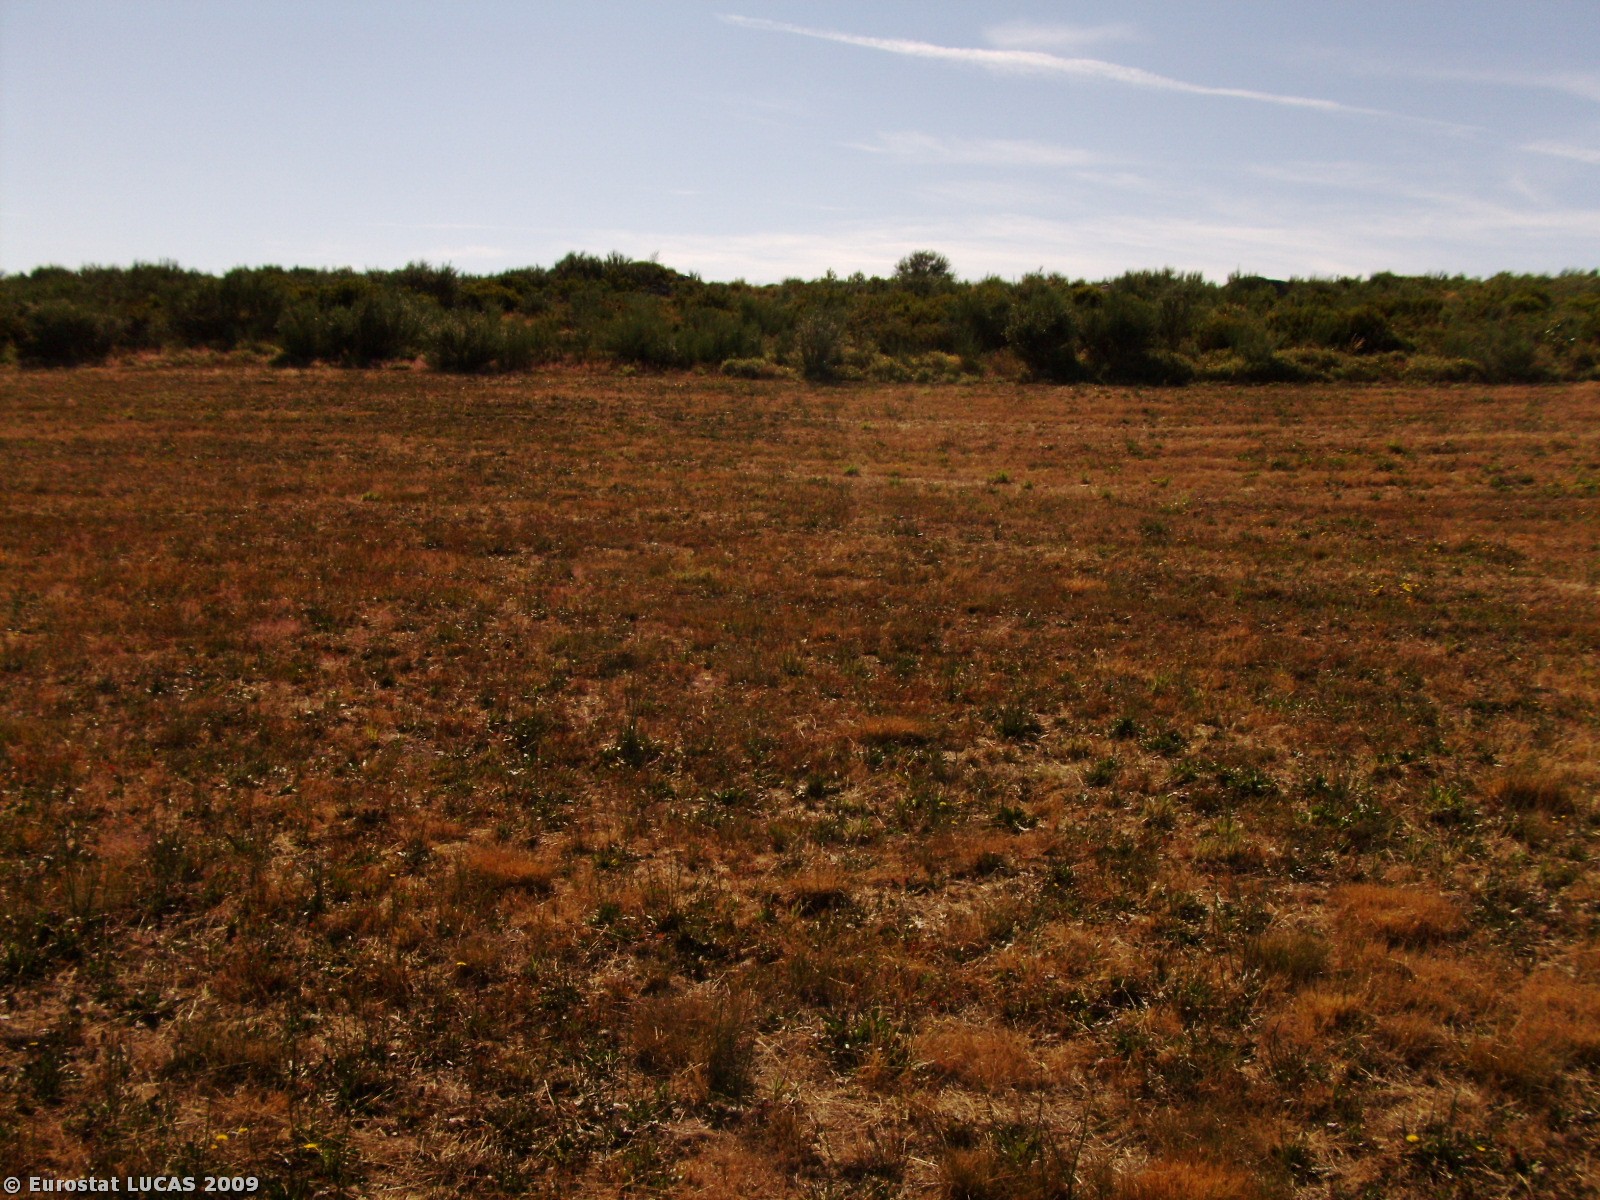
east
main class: Grassland
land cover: Spontaneously vegetated surfaces
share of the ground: > 75 %
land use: Fallow land
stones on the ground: < 10 %
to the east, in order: Spontaneously vegetated surfaces; Abandoned hedges; Dry stone walls; Shrubland without tree cover; Dry stone walls; Shrubland without tree cover; Broadleaved woodland; Coniferous woodland
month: July
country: PT
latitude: 40.9657
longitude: -7.7222
